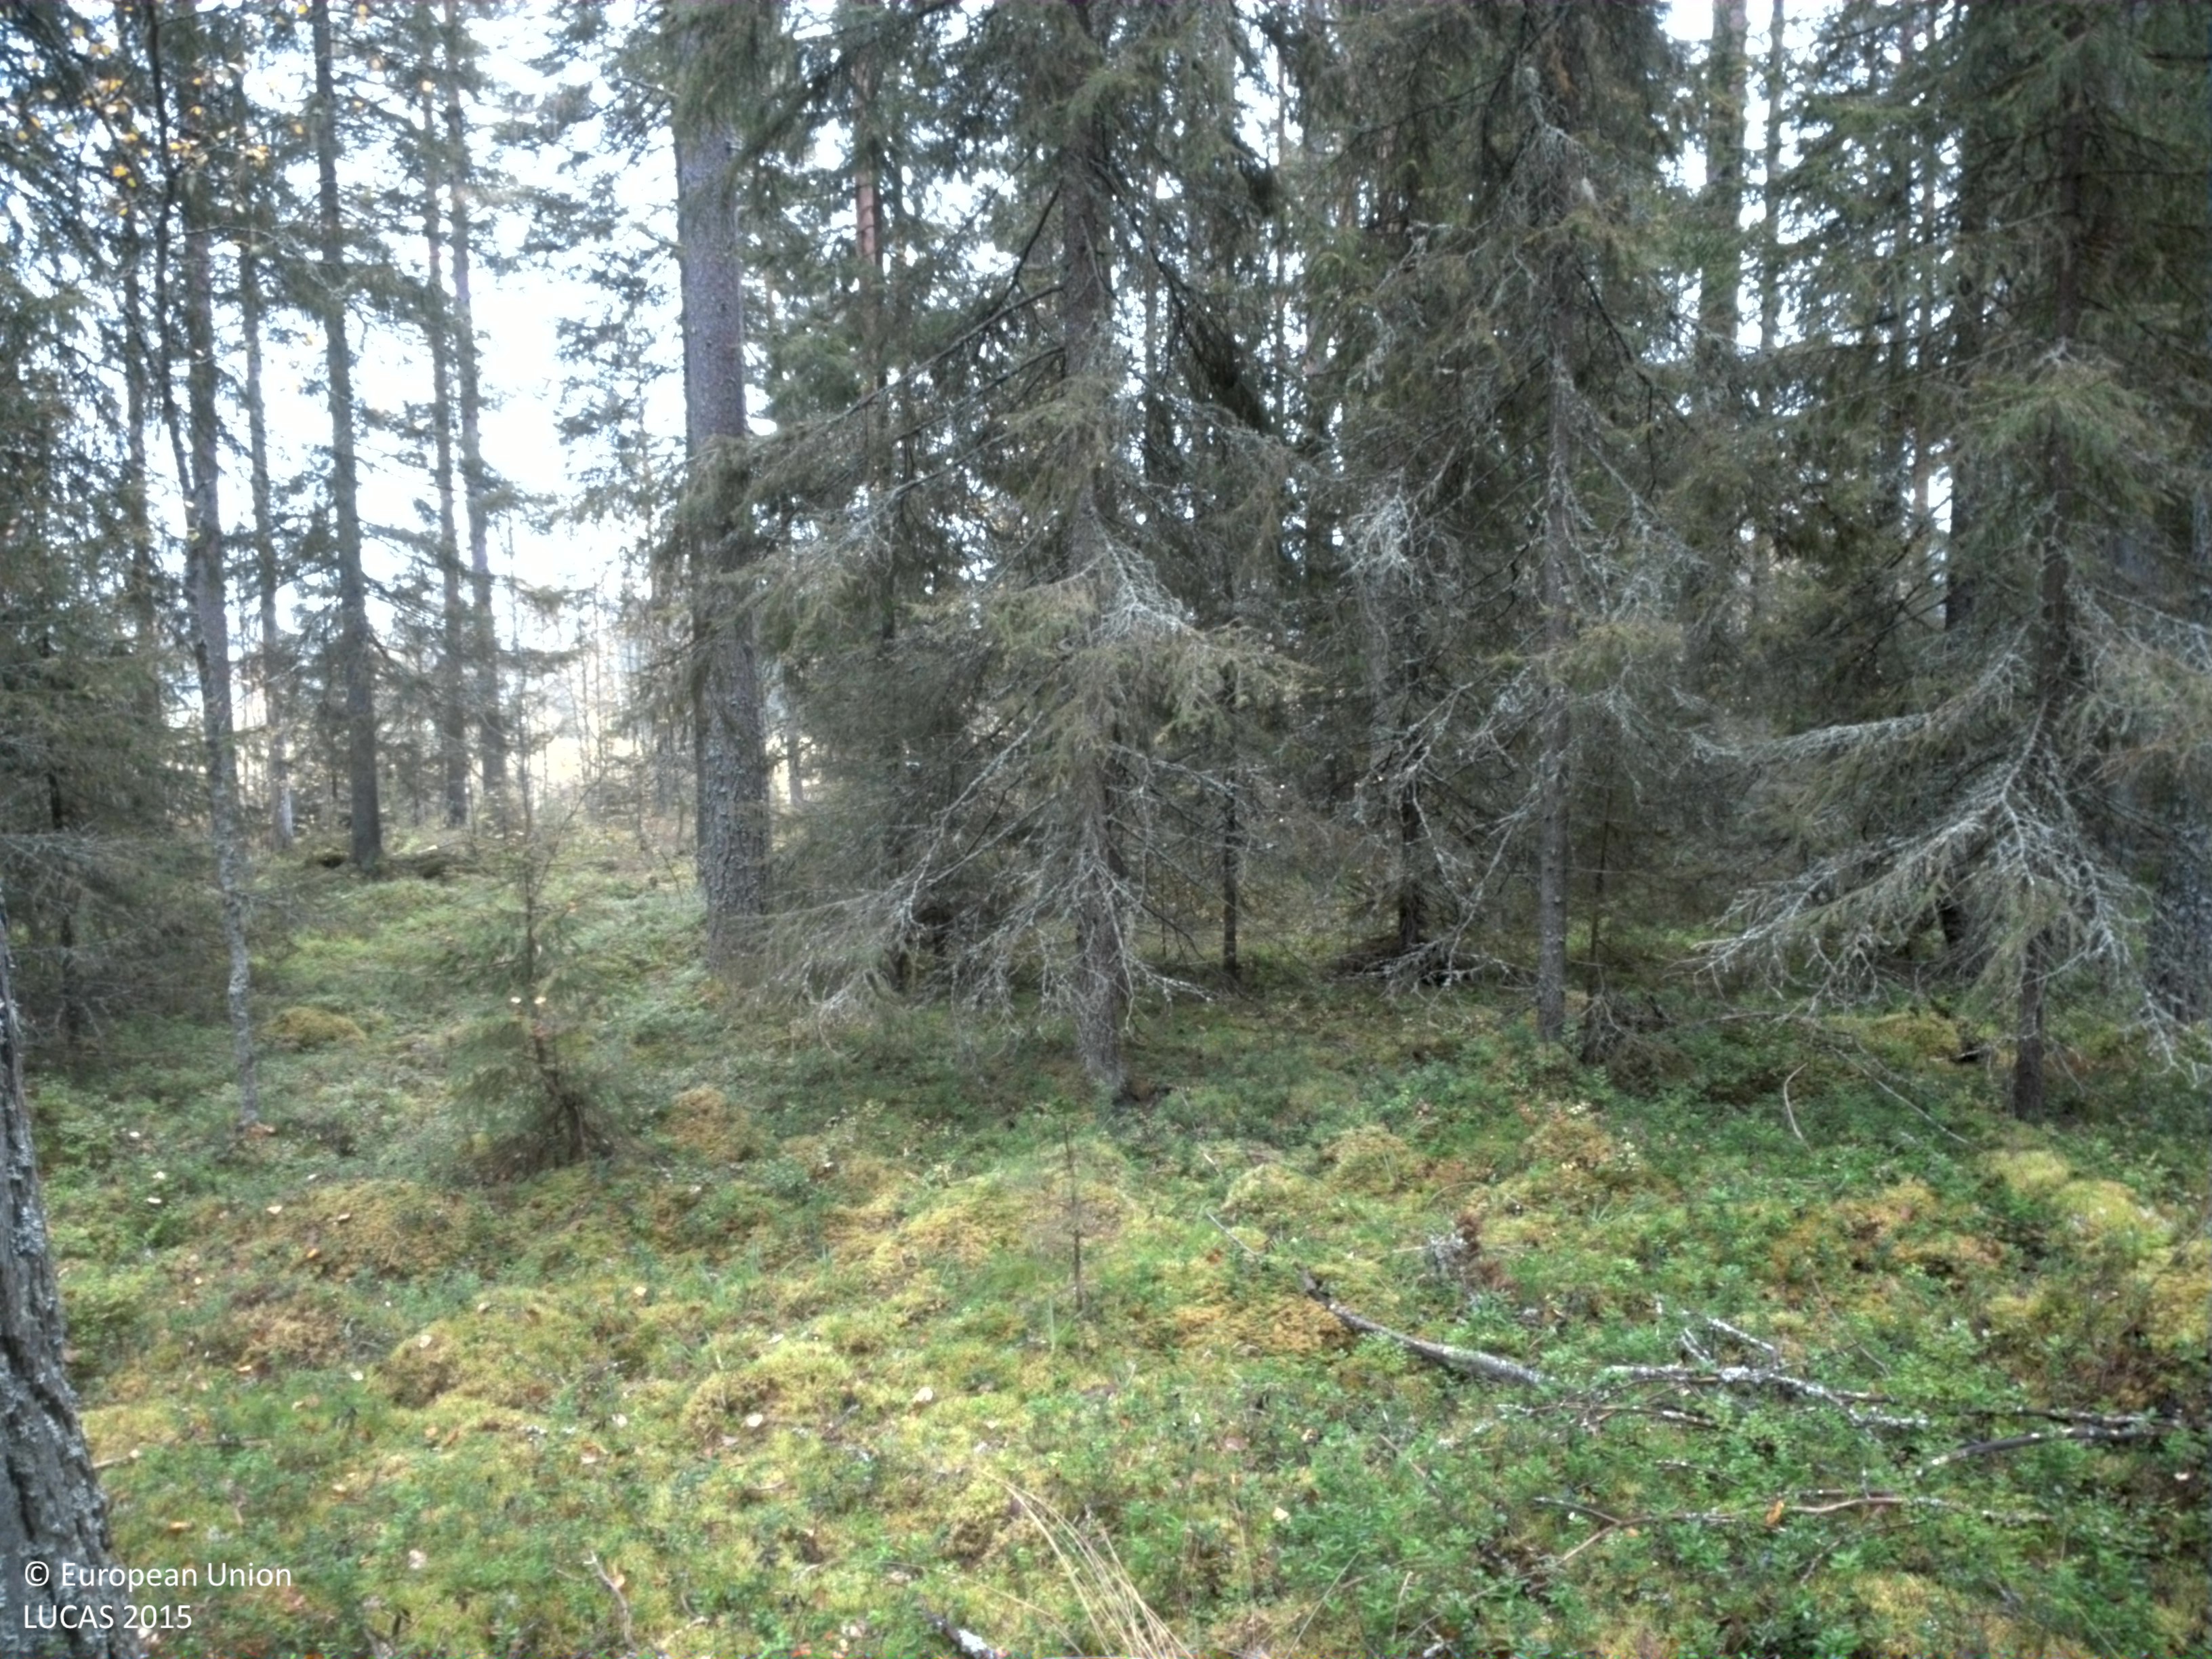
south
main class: Woodland
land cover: Pine dominated coniferous woodland
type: boreal forest
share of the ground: 25 - 50 %
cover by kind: shrubs 55 %, coniferous forest trees 35 %, broadleaved forest trees 5 %, lichens and mosses 5 %
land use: Forestry
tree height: > 5 m
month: September
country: SE
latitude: 65.8293
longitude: 21.9911
